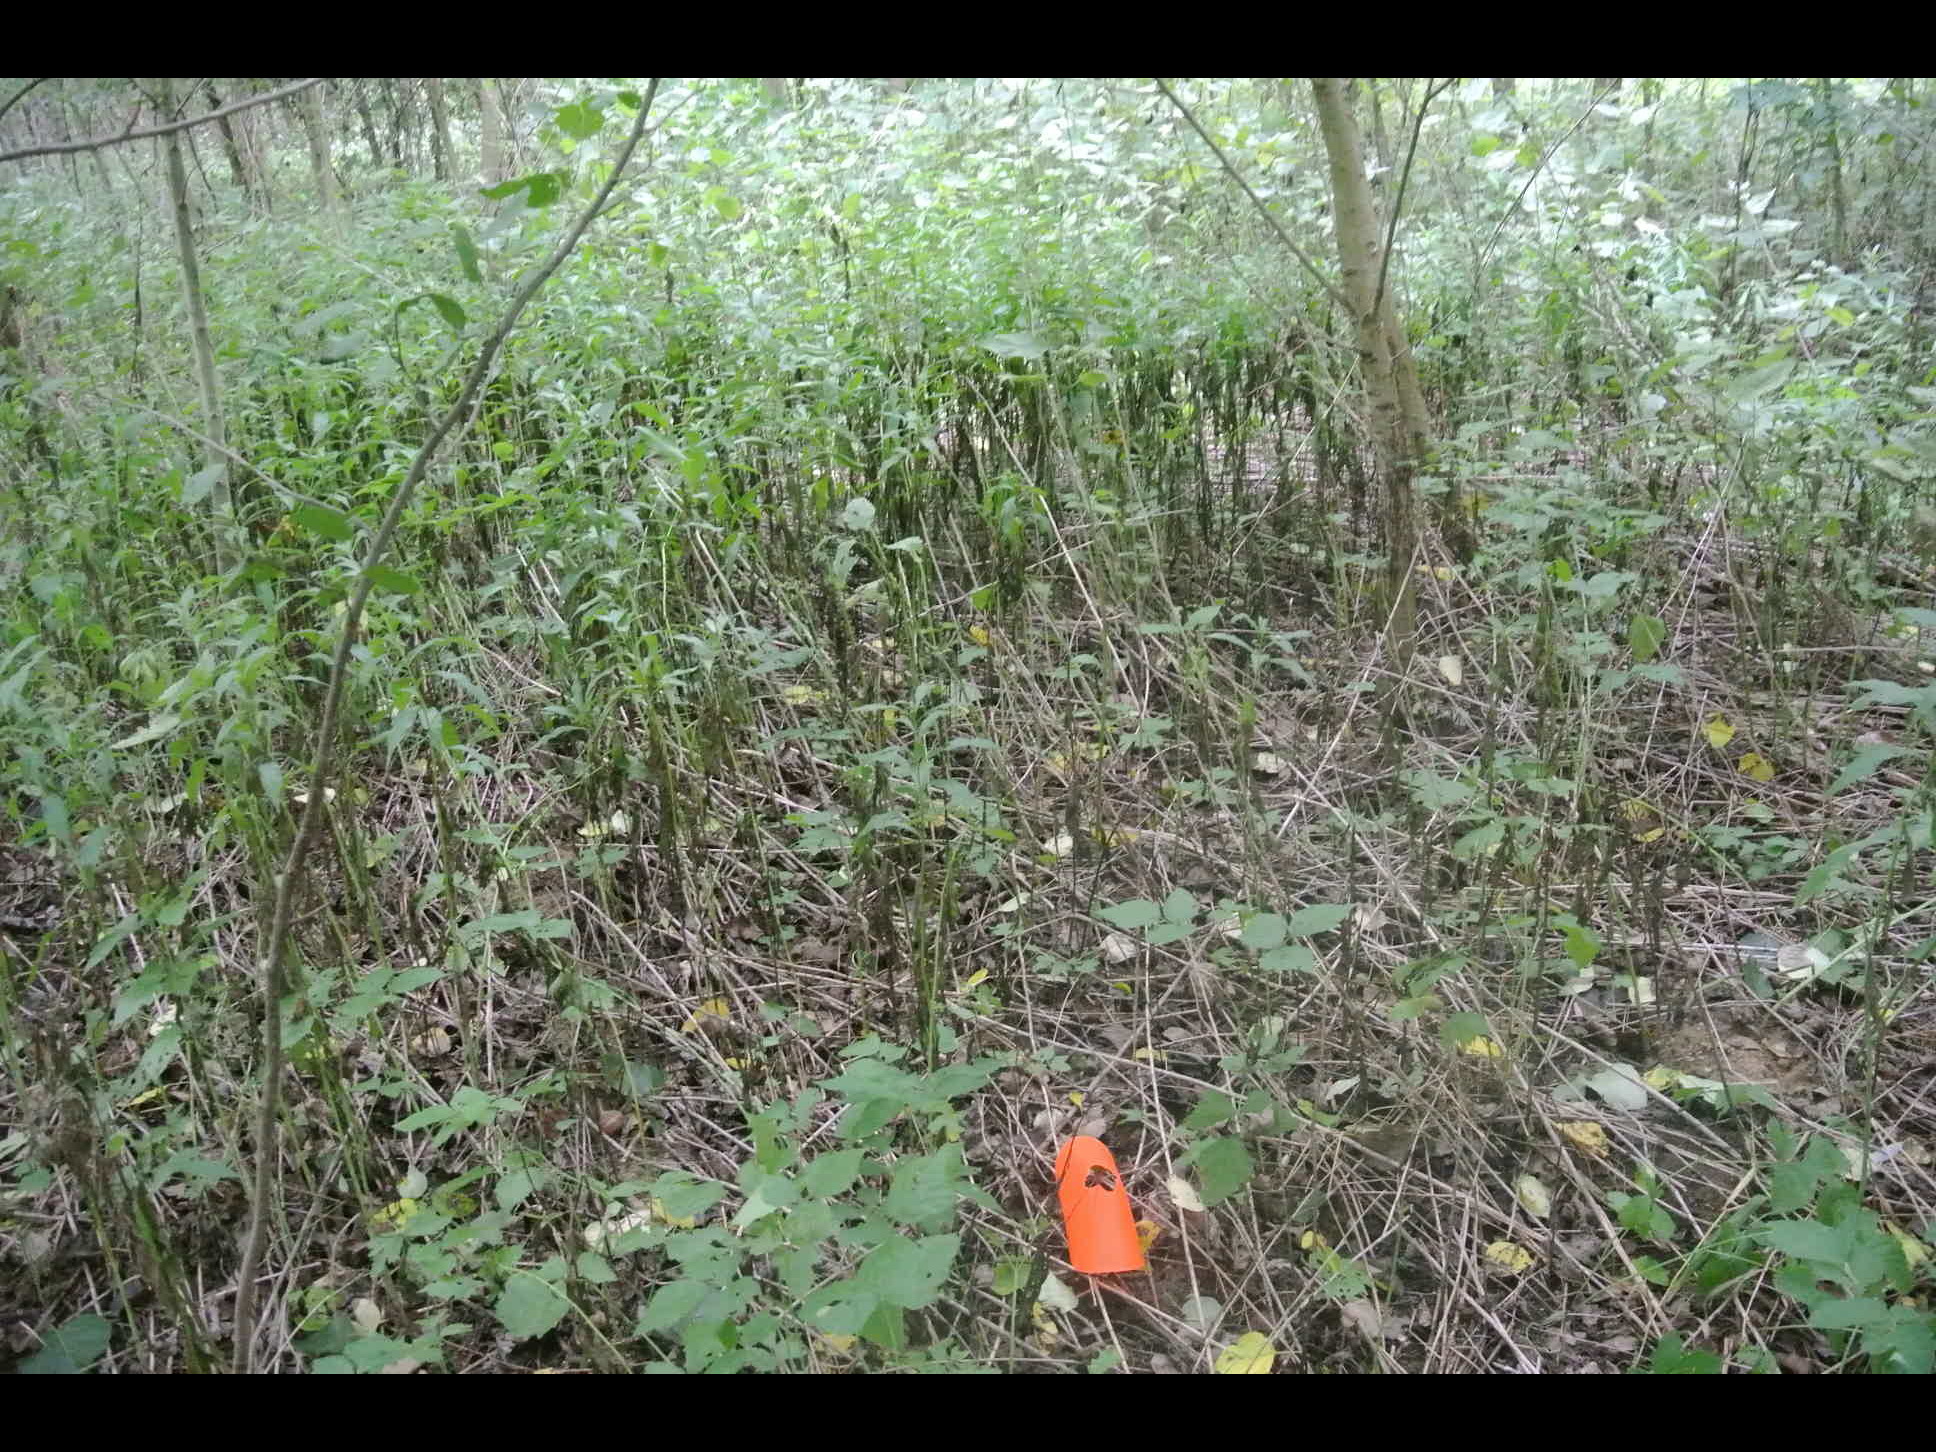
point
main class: Woodland
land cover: Broadleaved woodland
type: floodplain forest
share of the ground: > 75 %
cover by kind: broadleaved forest trees 100 %
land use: Forestry
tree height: > 5 m
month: July
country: AT
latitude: 47.4677
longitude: 16.5712
